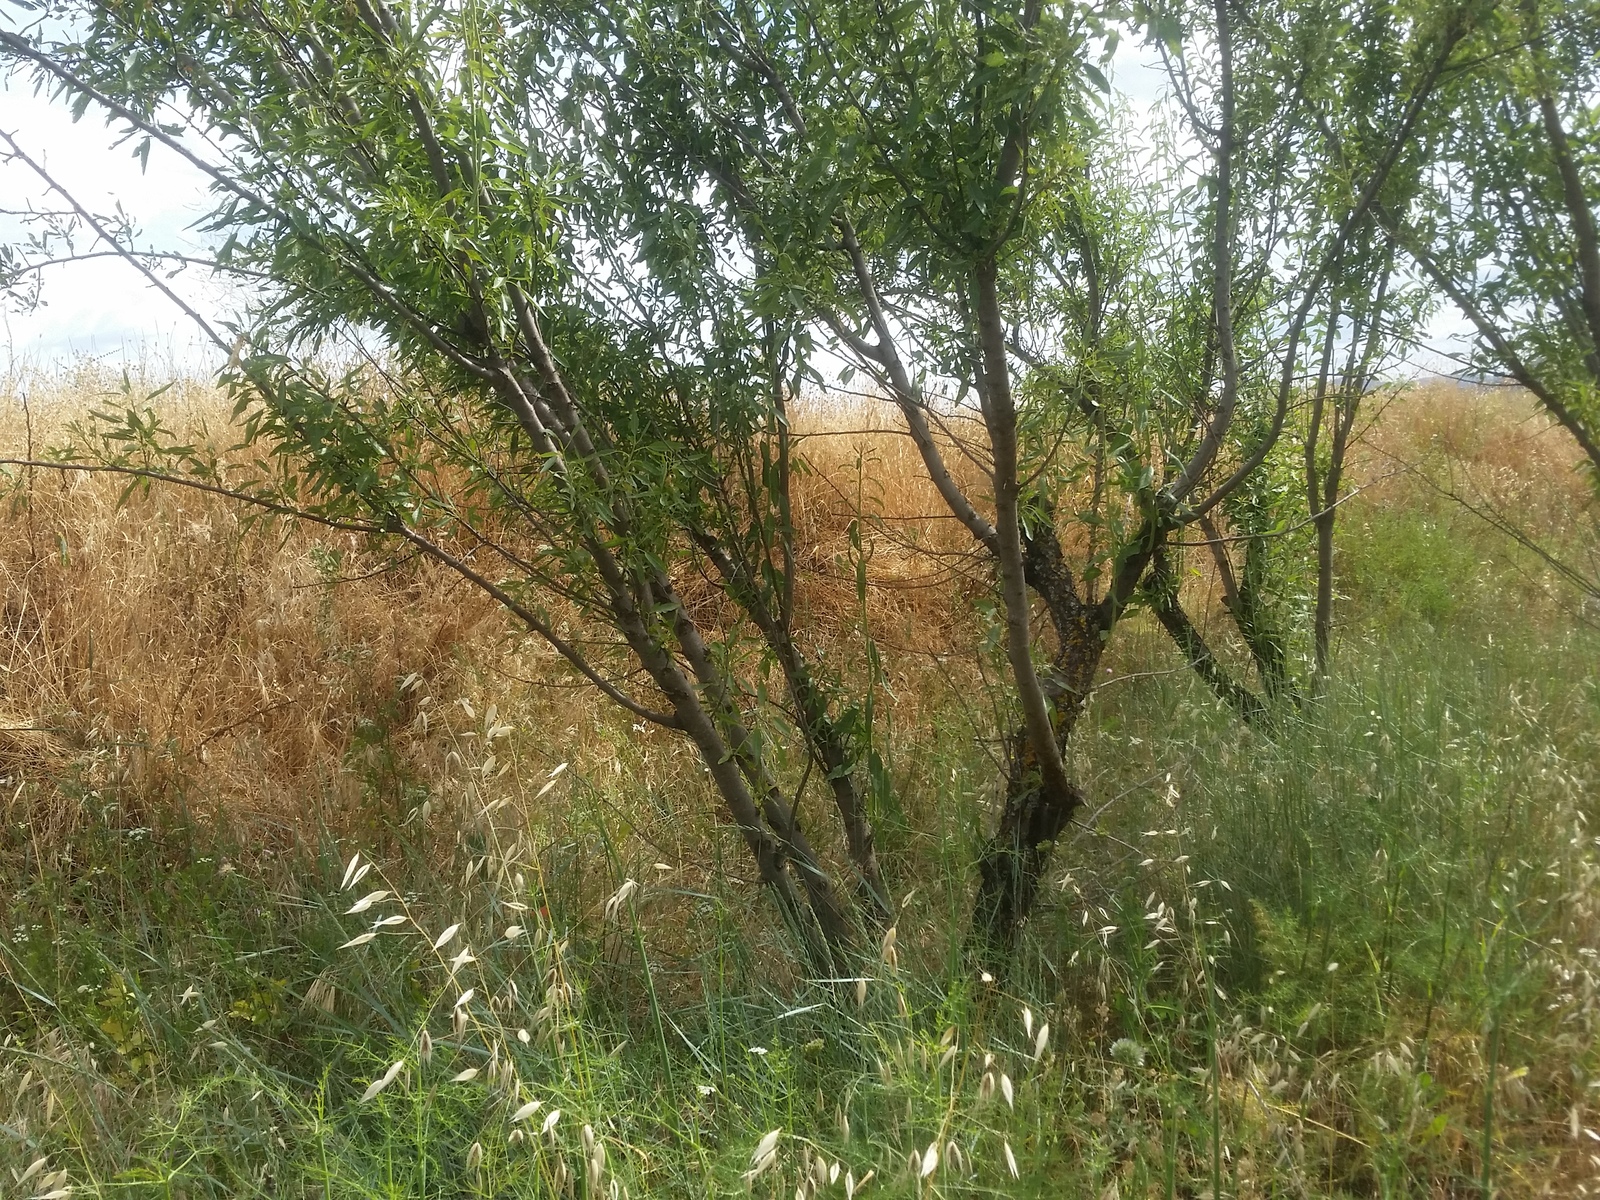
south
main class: Cropland
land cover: Nuts trees
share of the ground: 50 - 75 %
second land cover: Grassland without tree/shrub cover
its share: > 75 %
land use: Abandoned areas
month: June
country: ES
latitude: 38.7021
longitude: -2.5935
